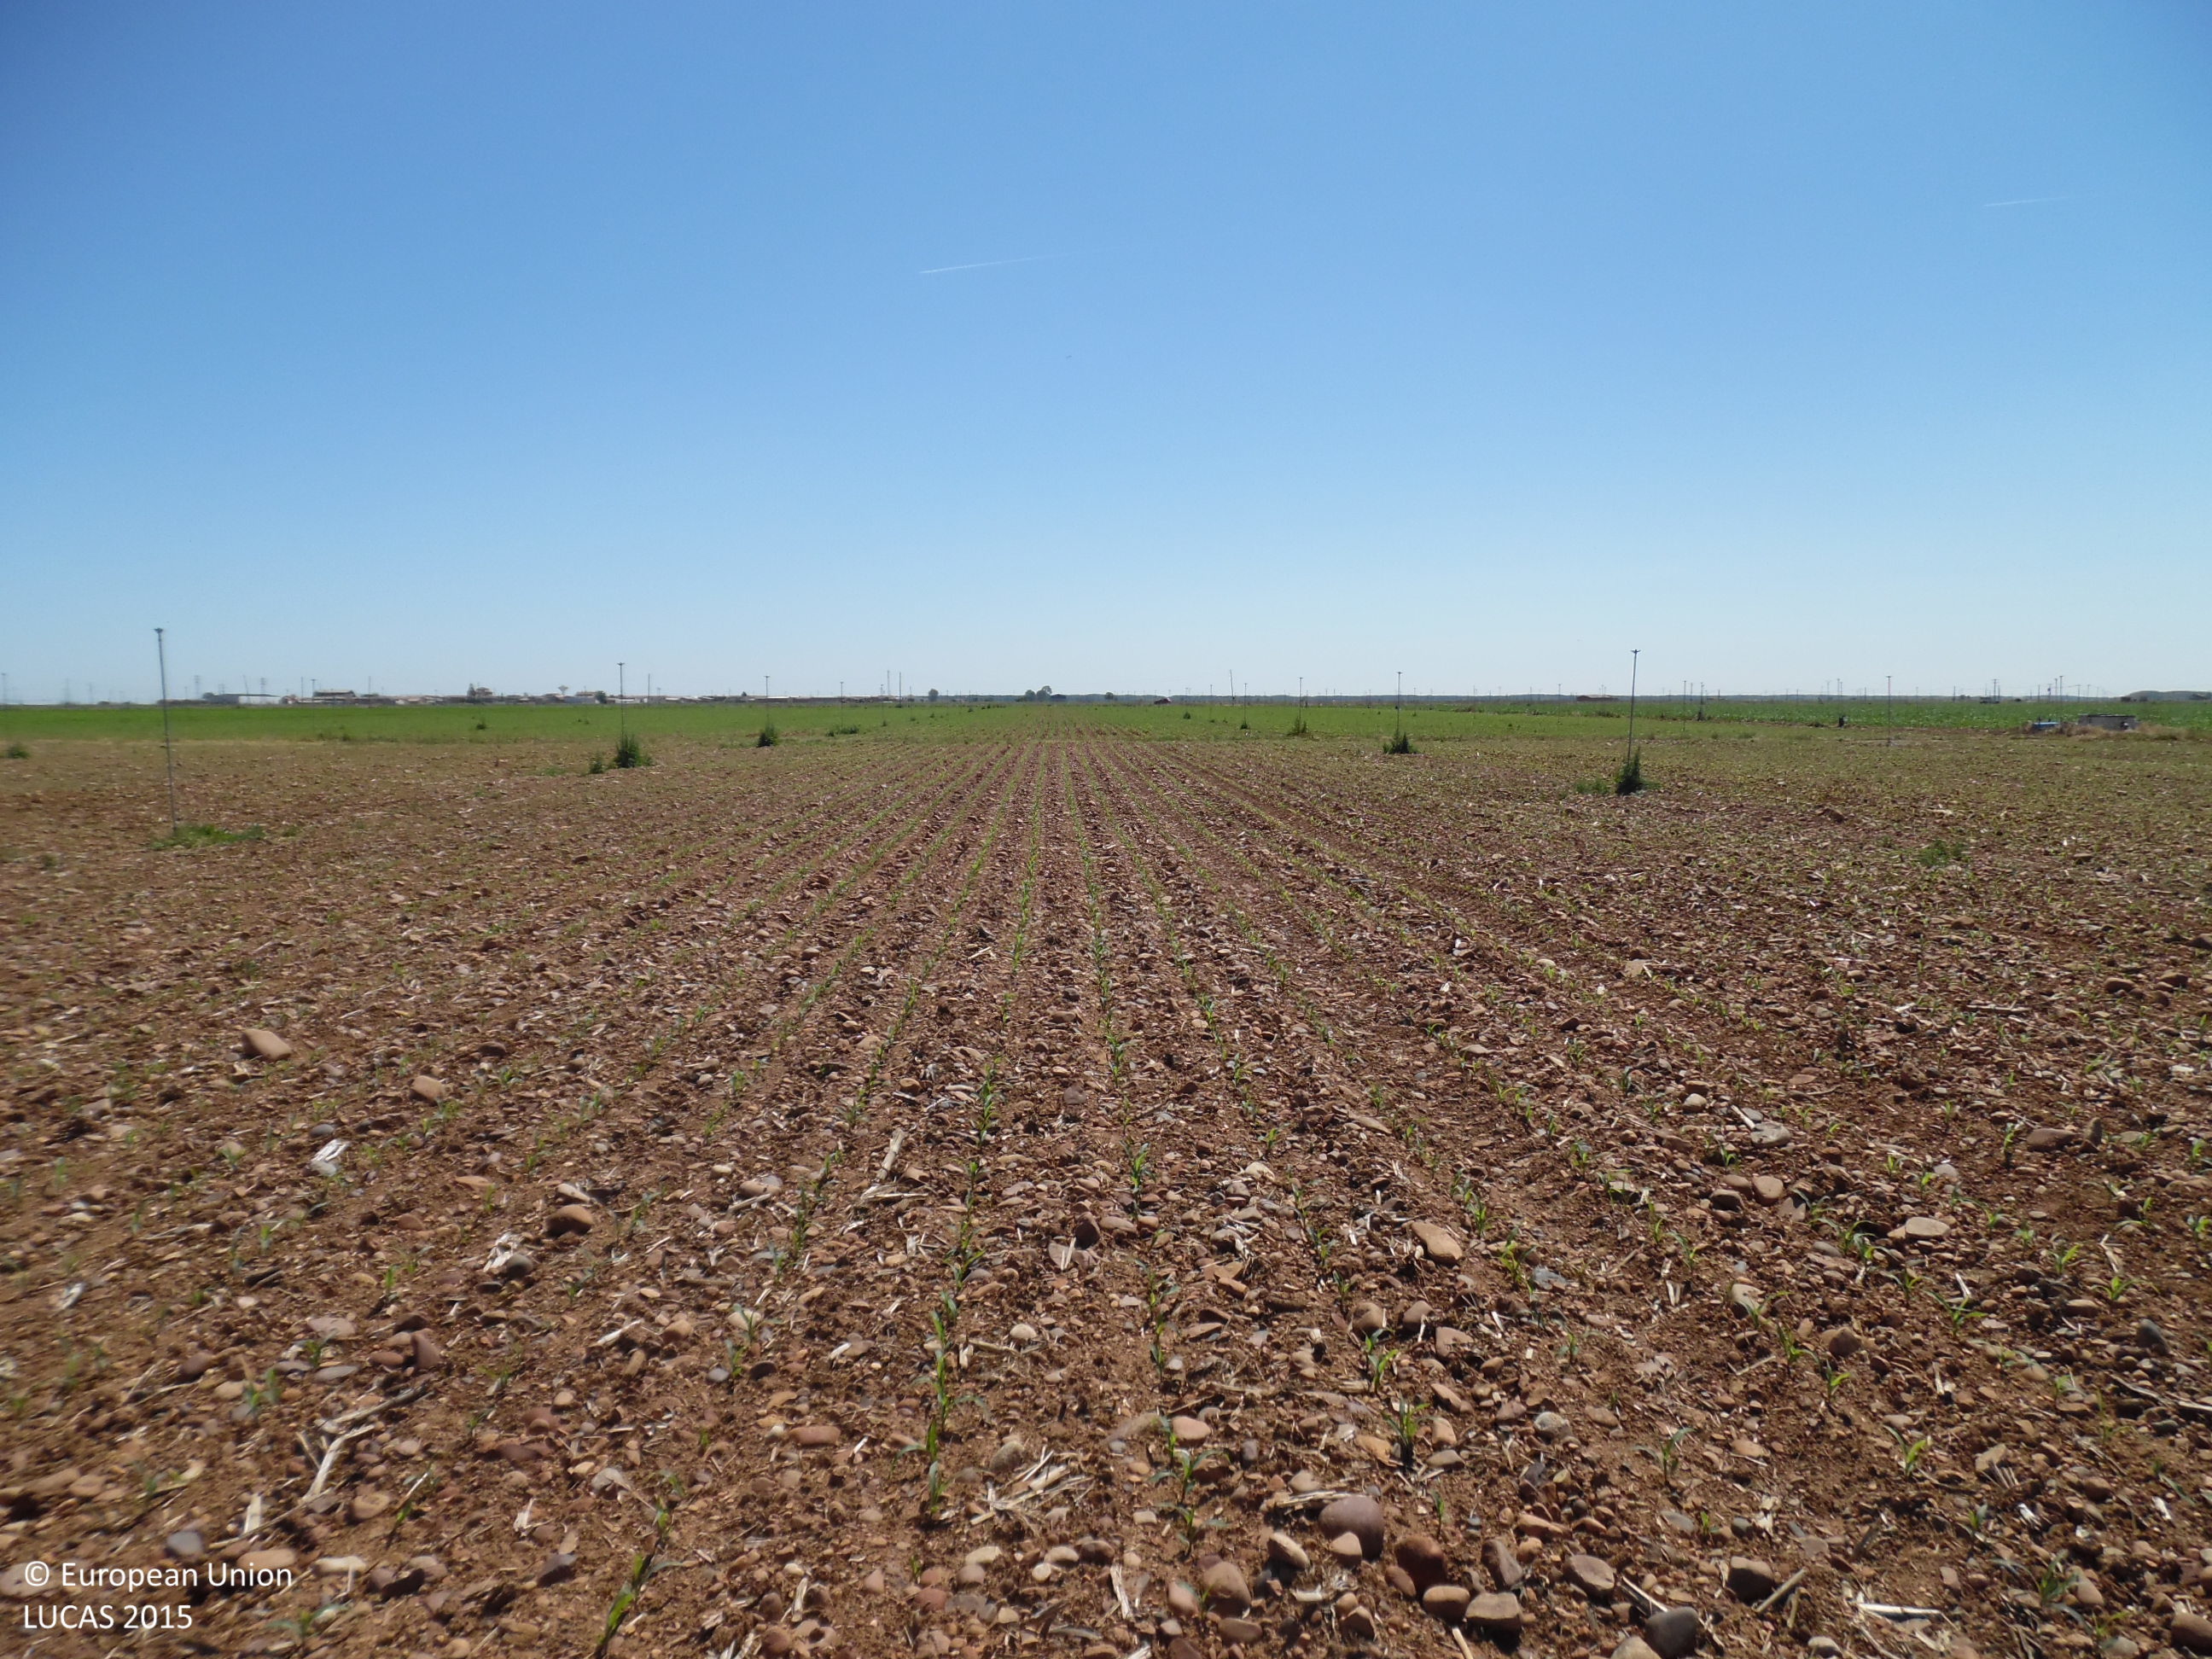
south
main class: Cropland
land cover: Maize
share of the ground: < 10 %
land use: Agriculture (excluding fallow land and kitchen gardens)
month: June
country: ES
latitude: 42.3010
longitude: -5.7078
